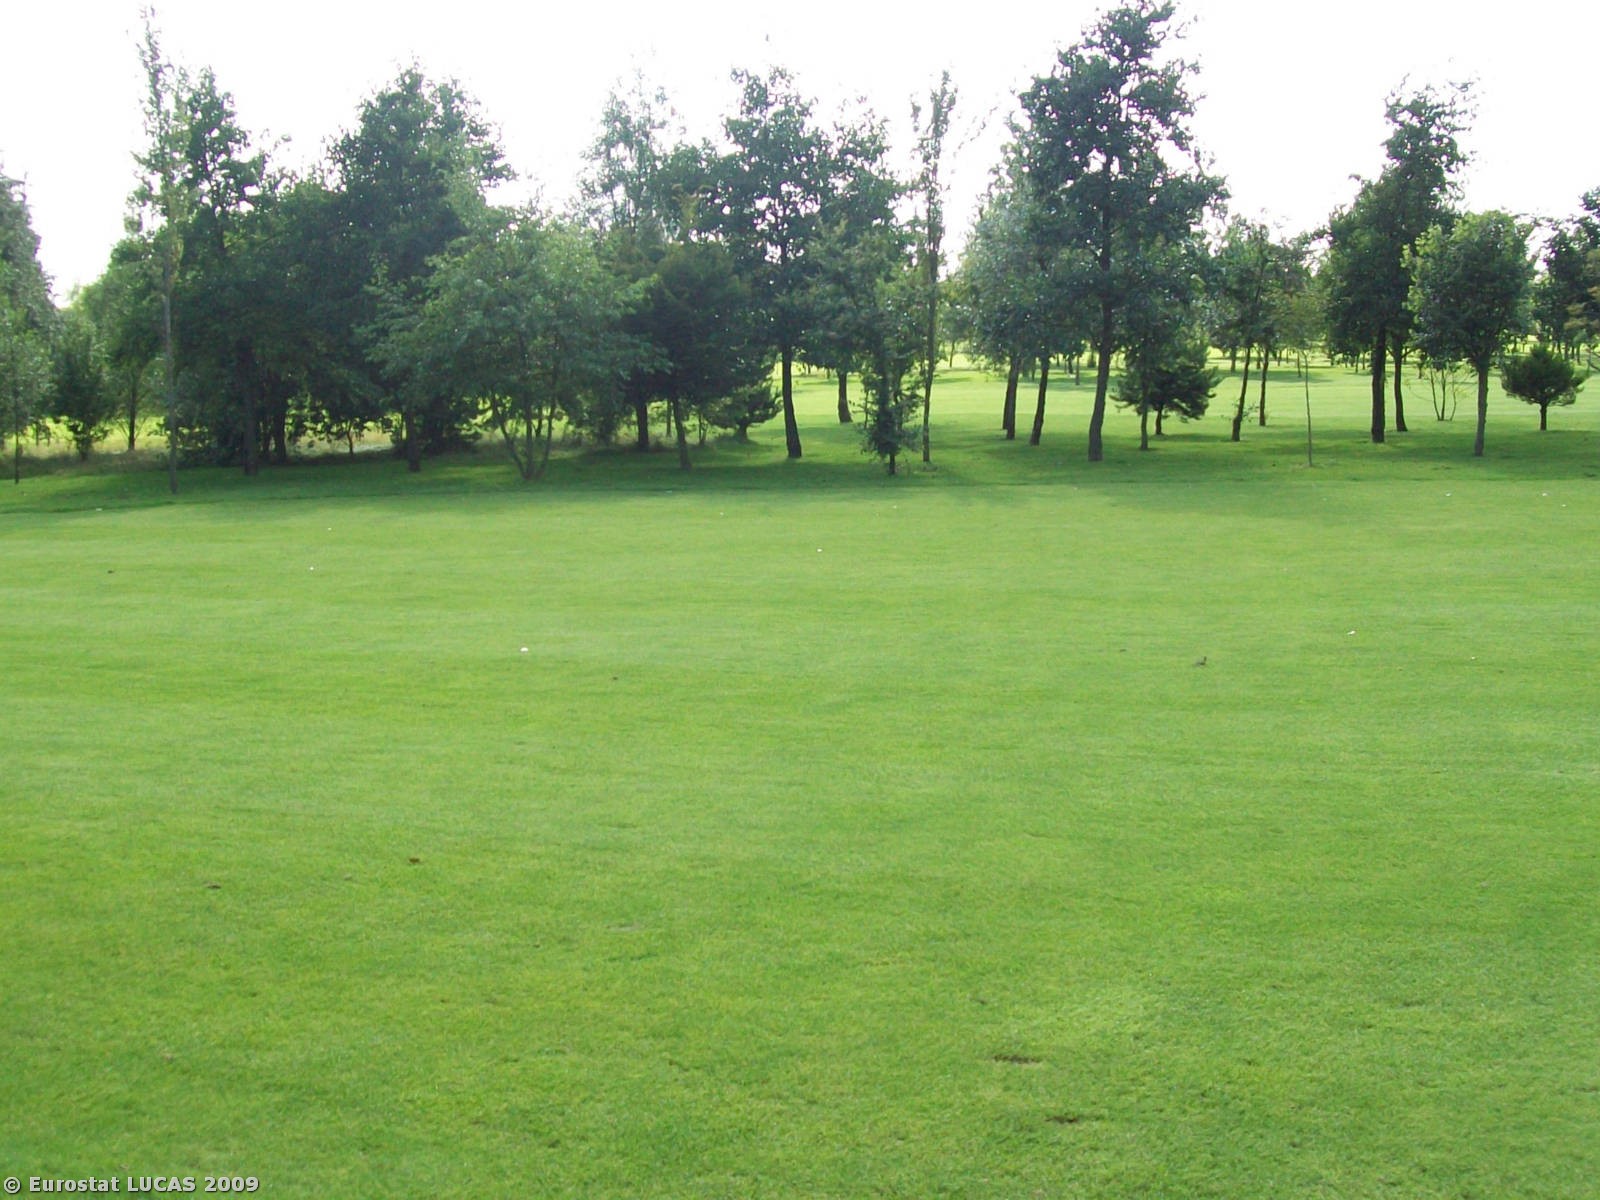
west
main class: Grassland
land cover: Grassland without tree/shrub cover
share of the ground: > 75 %
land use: Sport
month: July
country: GB
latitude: 53.2959
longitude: -1.2241
